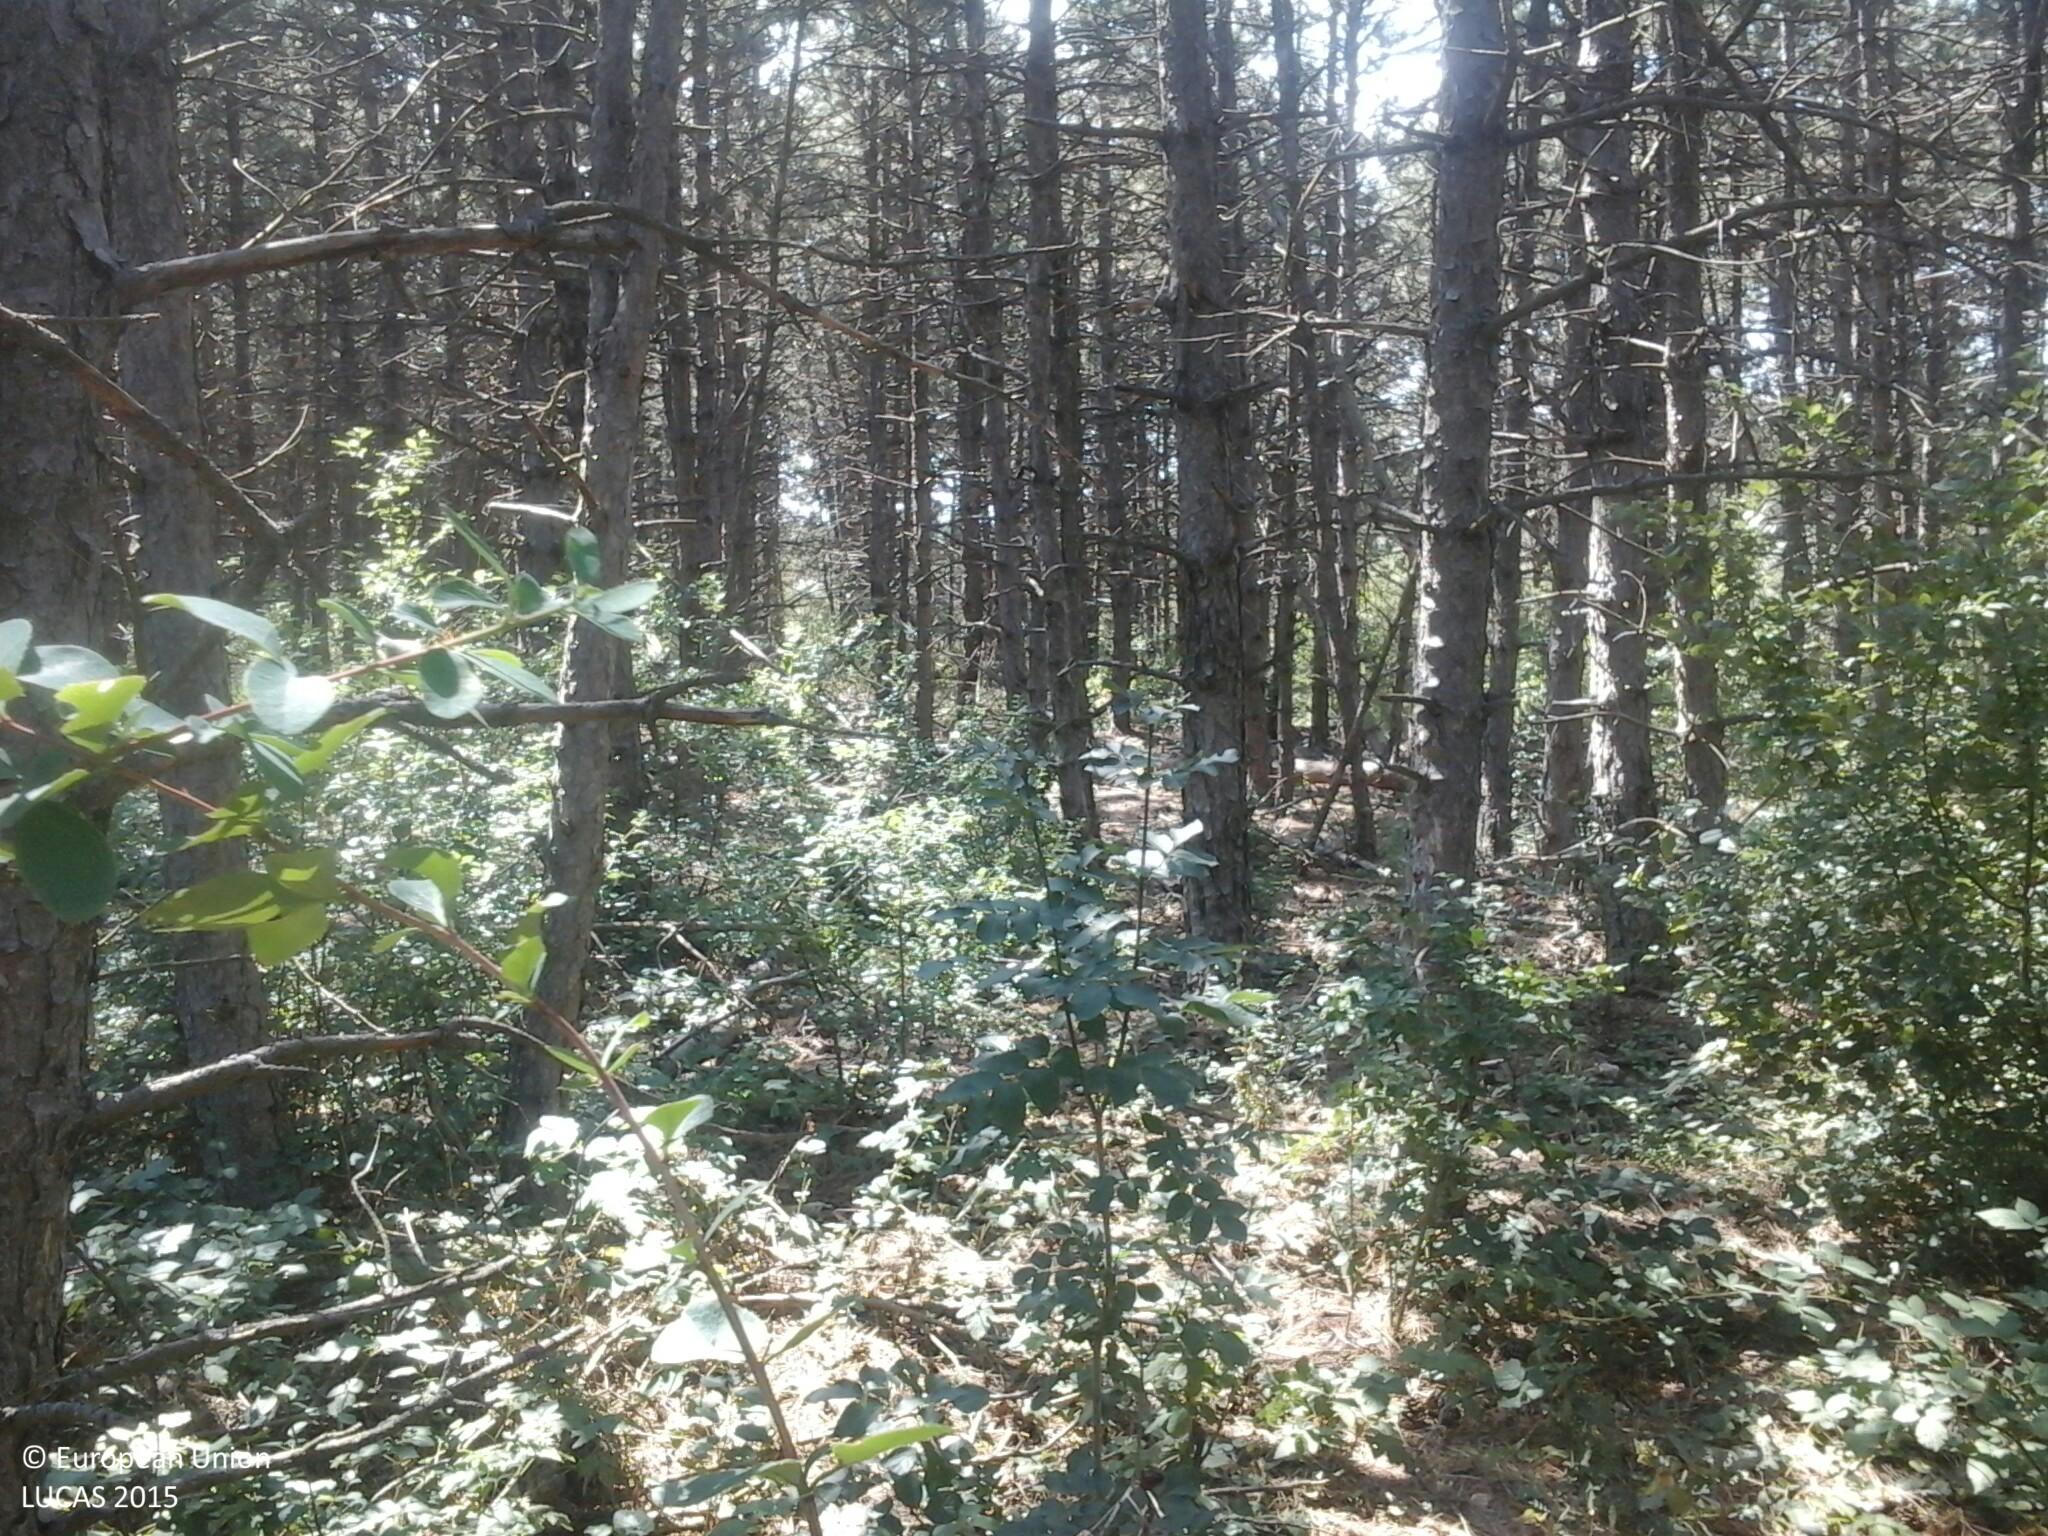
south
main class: Woodland
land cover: Other coniferous woodland
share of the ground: > 75 %
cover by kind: coniferous forest trees 70 %, shrubs 20 %, herbaceous plants 10 %
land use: Forestry
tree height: < 5 m
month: July
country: HU
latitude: 47.2154
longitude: 18.1577
